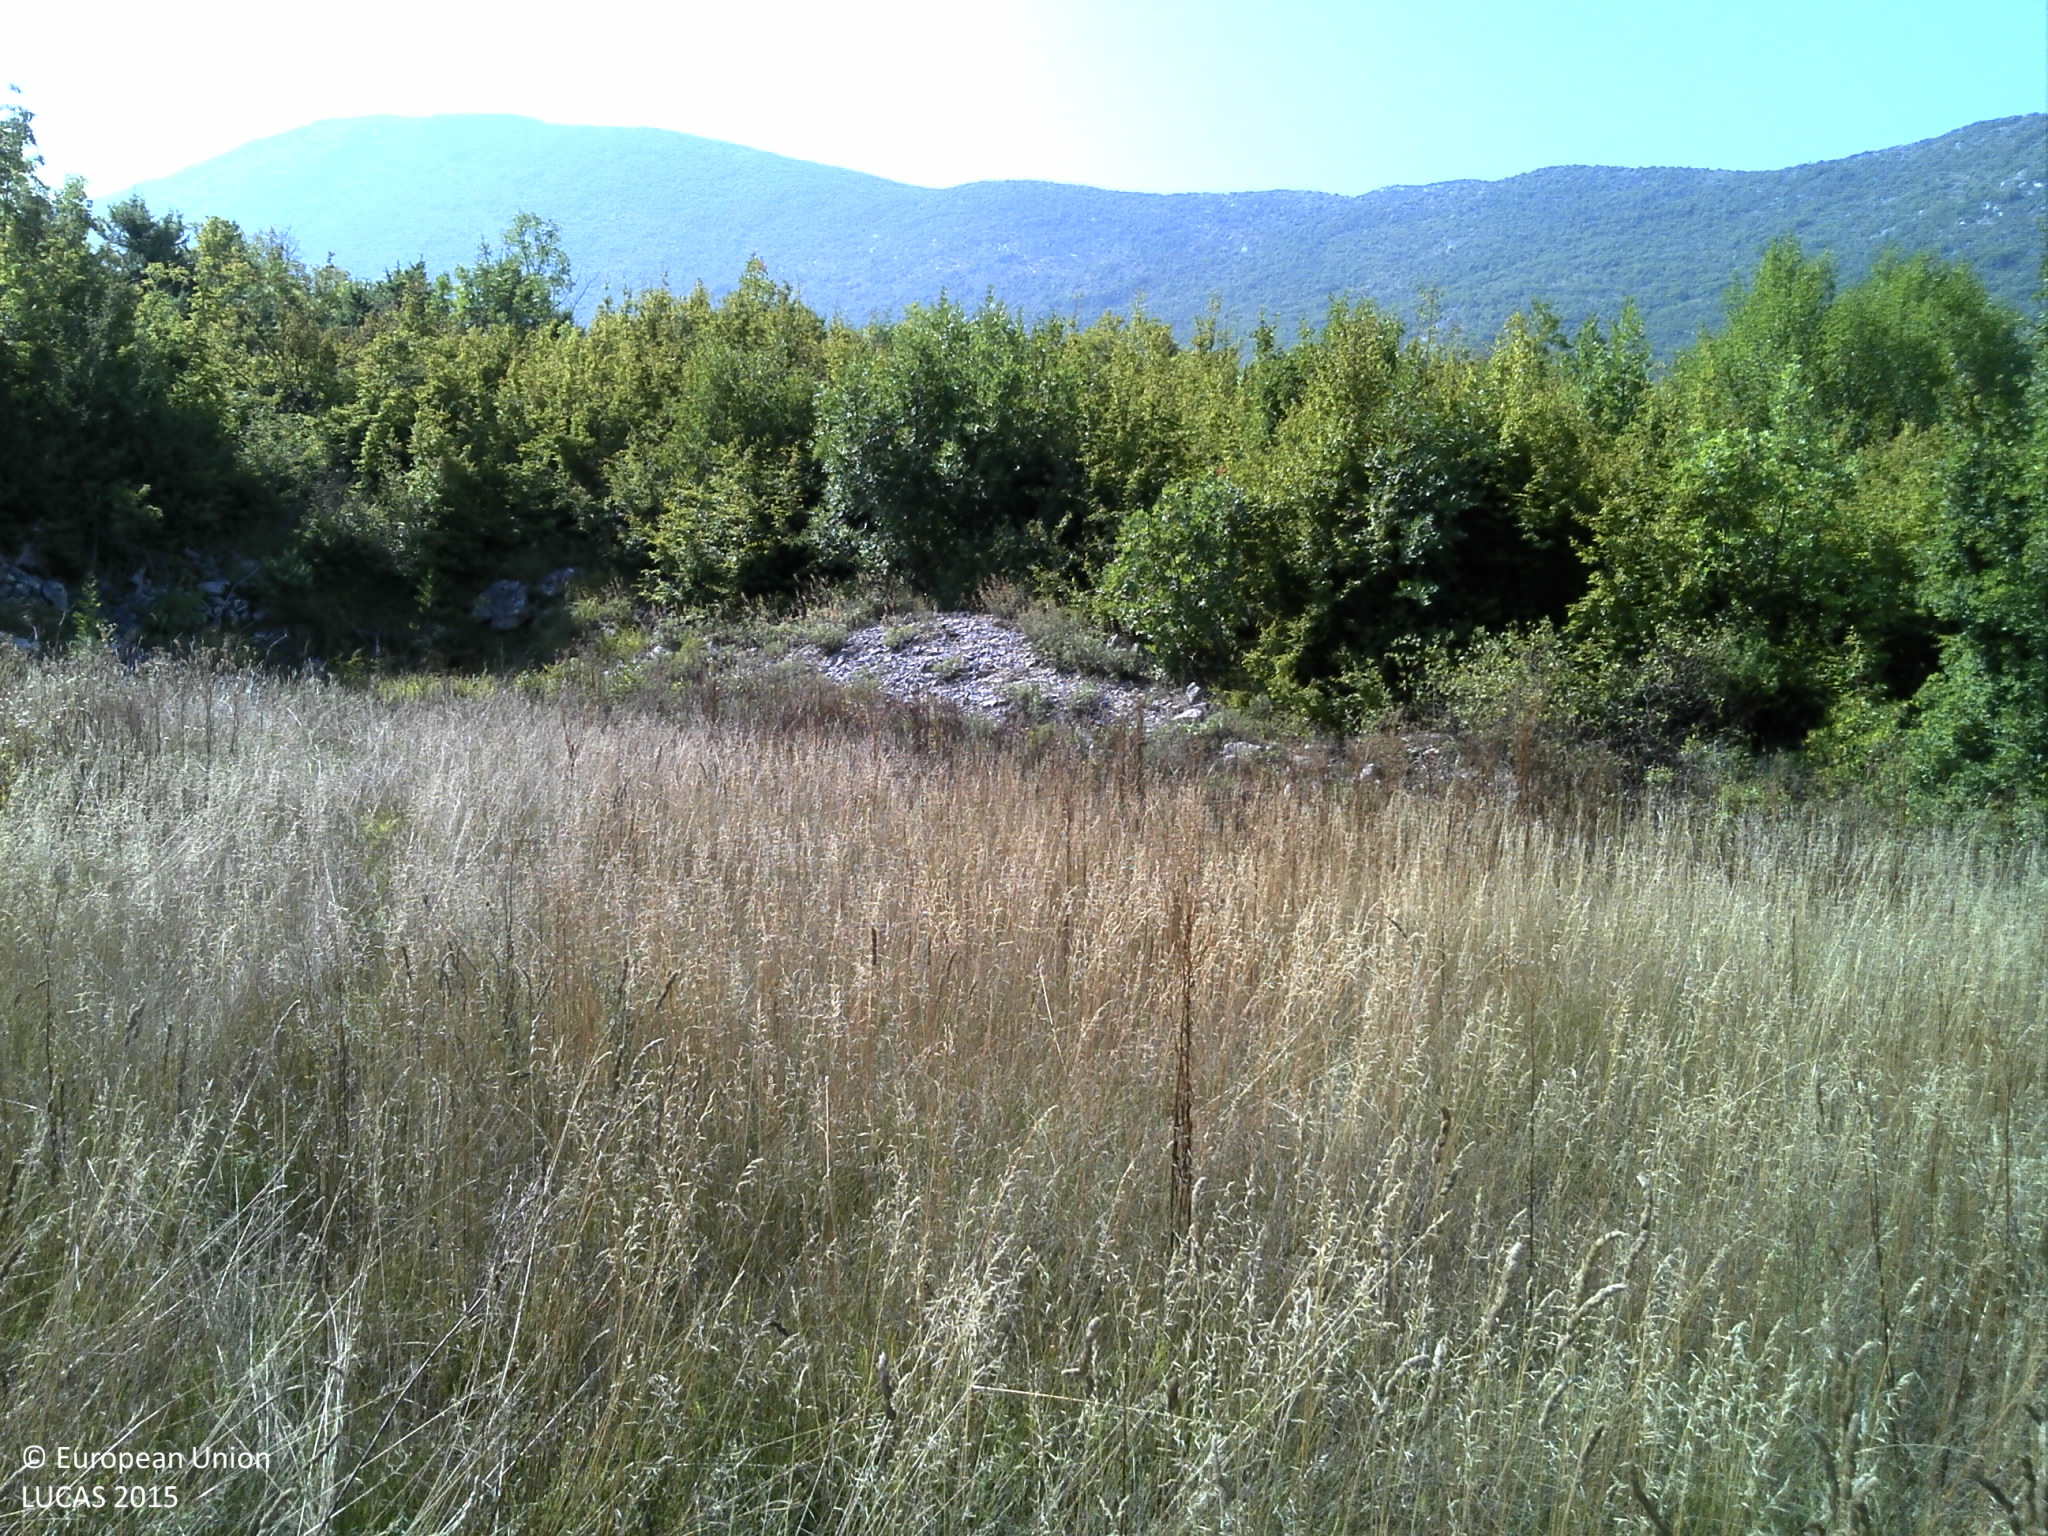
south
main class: Grassland
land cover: Grassland without tree/shrub cover
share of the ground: > 75 %
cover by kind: herbaceous plants 85 %, shrubs 5 %, consolidated bare surface 5 %, unconsolidated bare surface 5 %
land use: Abandoned areas
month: August
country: HR
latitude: 43.2408
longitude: 17.3186
